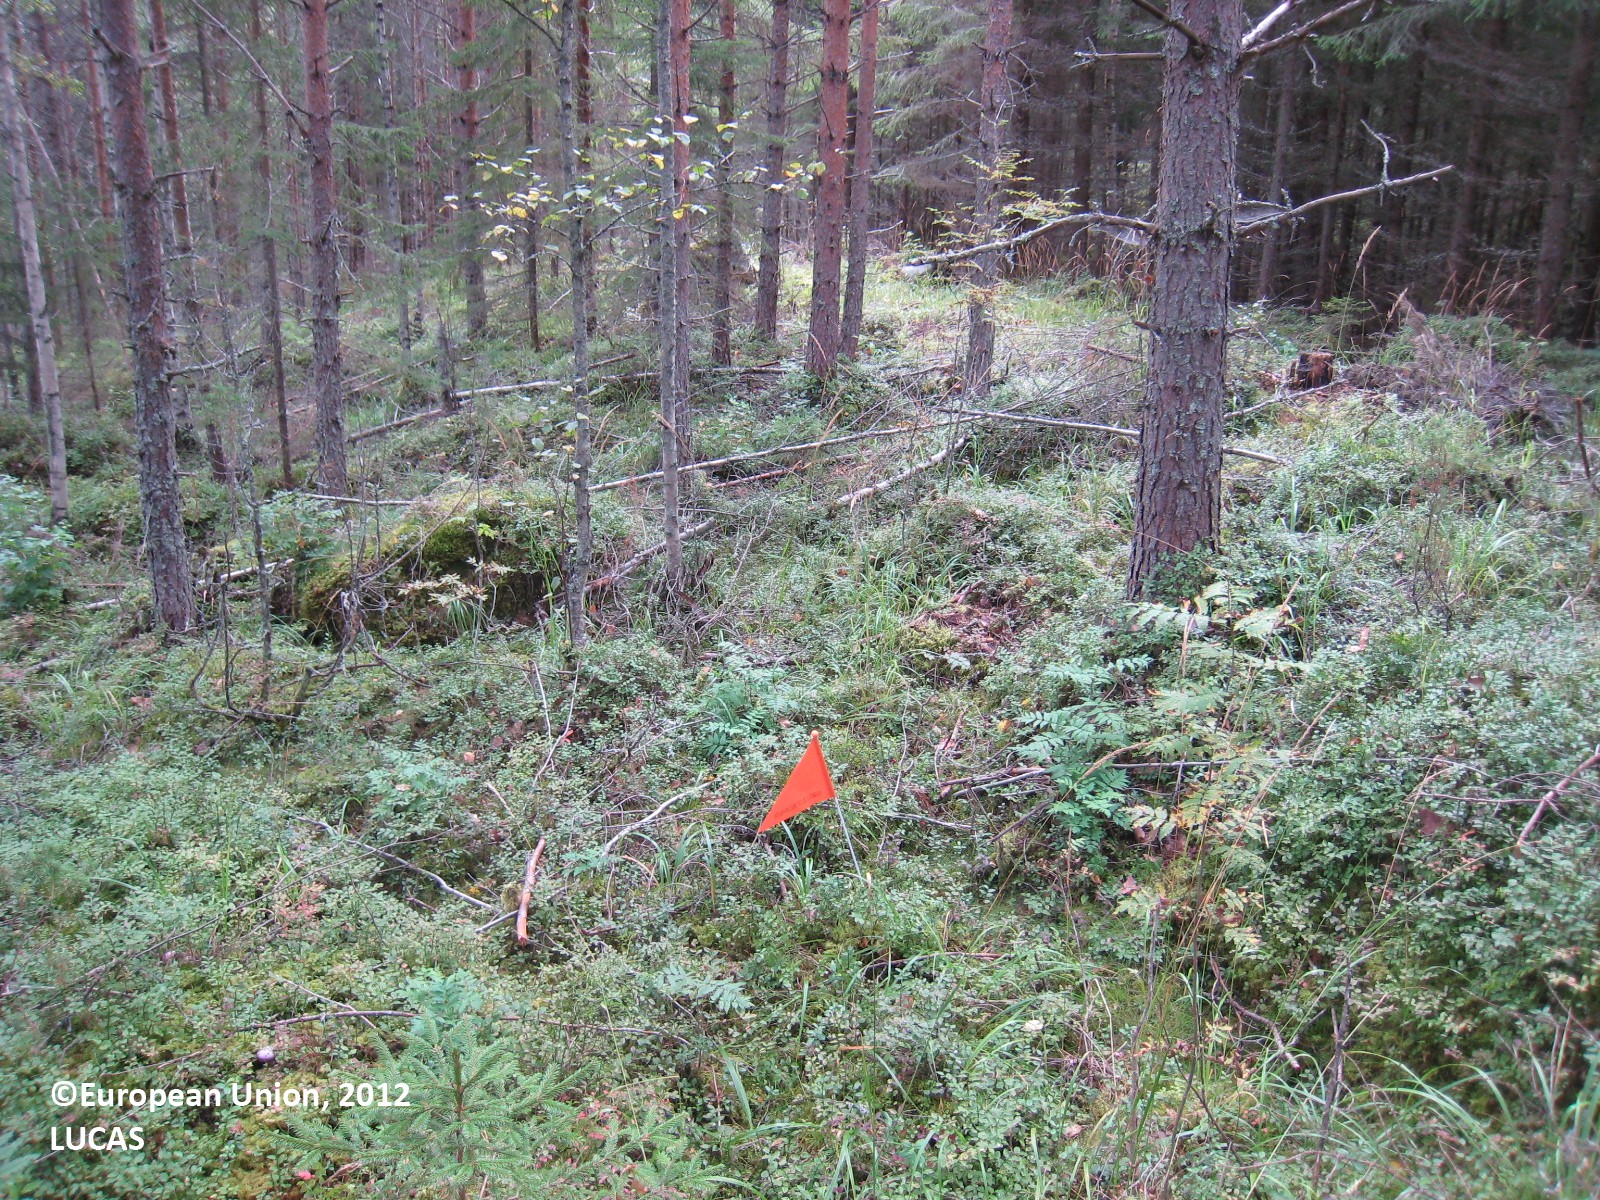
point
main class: Woodland
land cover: Pine dominated coniferous woodland
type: boreal forest
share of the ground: > 75 %
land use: Forestry
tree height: > 5 m
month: August
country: FI
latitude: 62.1372
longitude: 27.2924
